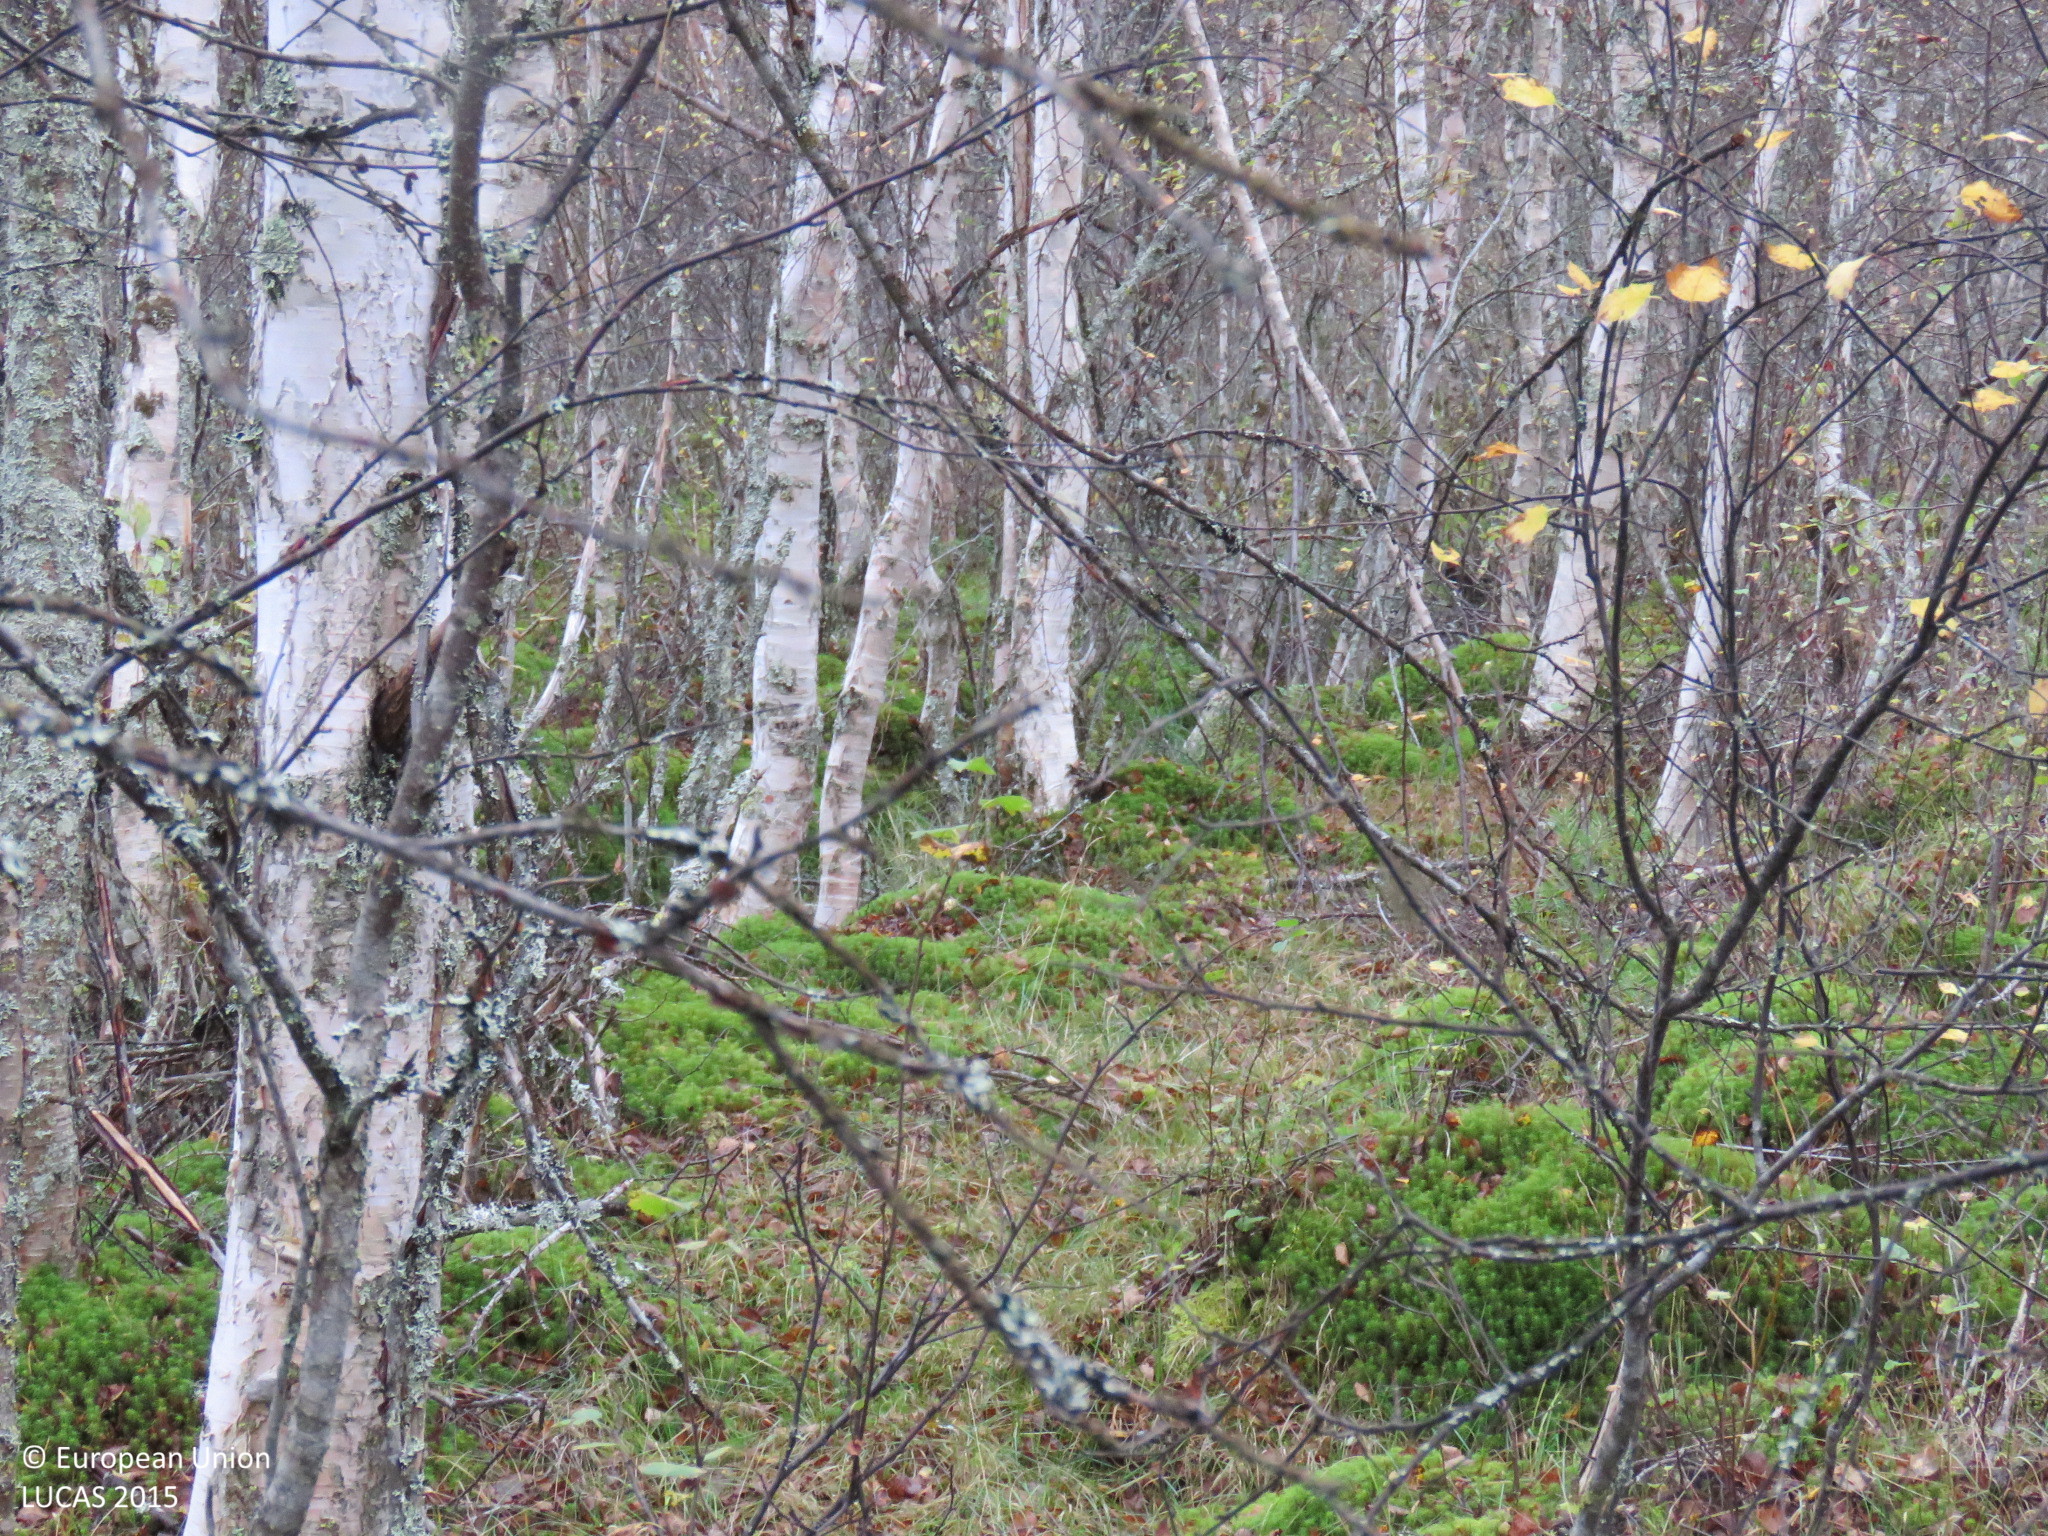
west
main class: Woodland
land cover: Broadleaved woodland
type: mire and swamp forests
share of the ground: > 75 %
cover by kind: broadleaved forest trees 70 %, coniferous forest trees 10 %, herbaceous plants 10 %, lichens and mosses 10 %
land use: Forestry
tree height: > 5 m
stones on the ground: < 10 %
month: September
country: FI
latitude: 65.1924
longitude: 26.8837
